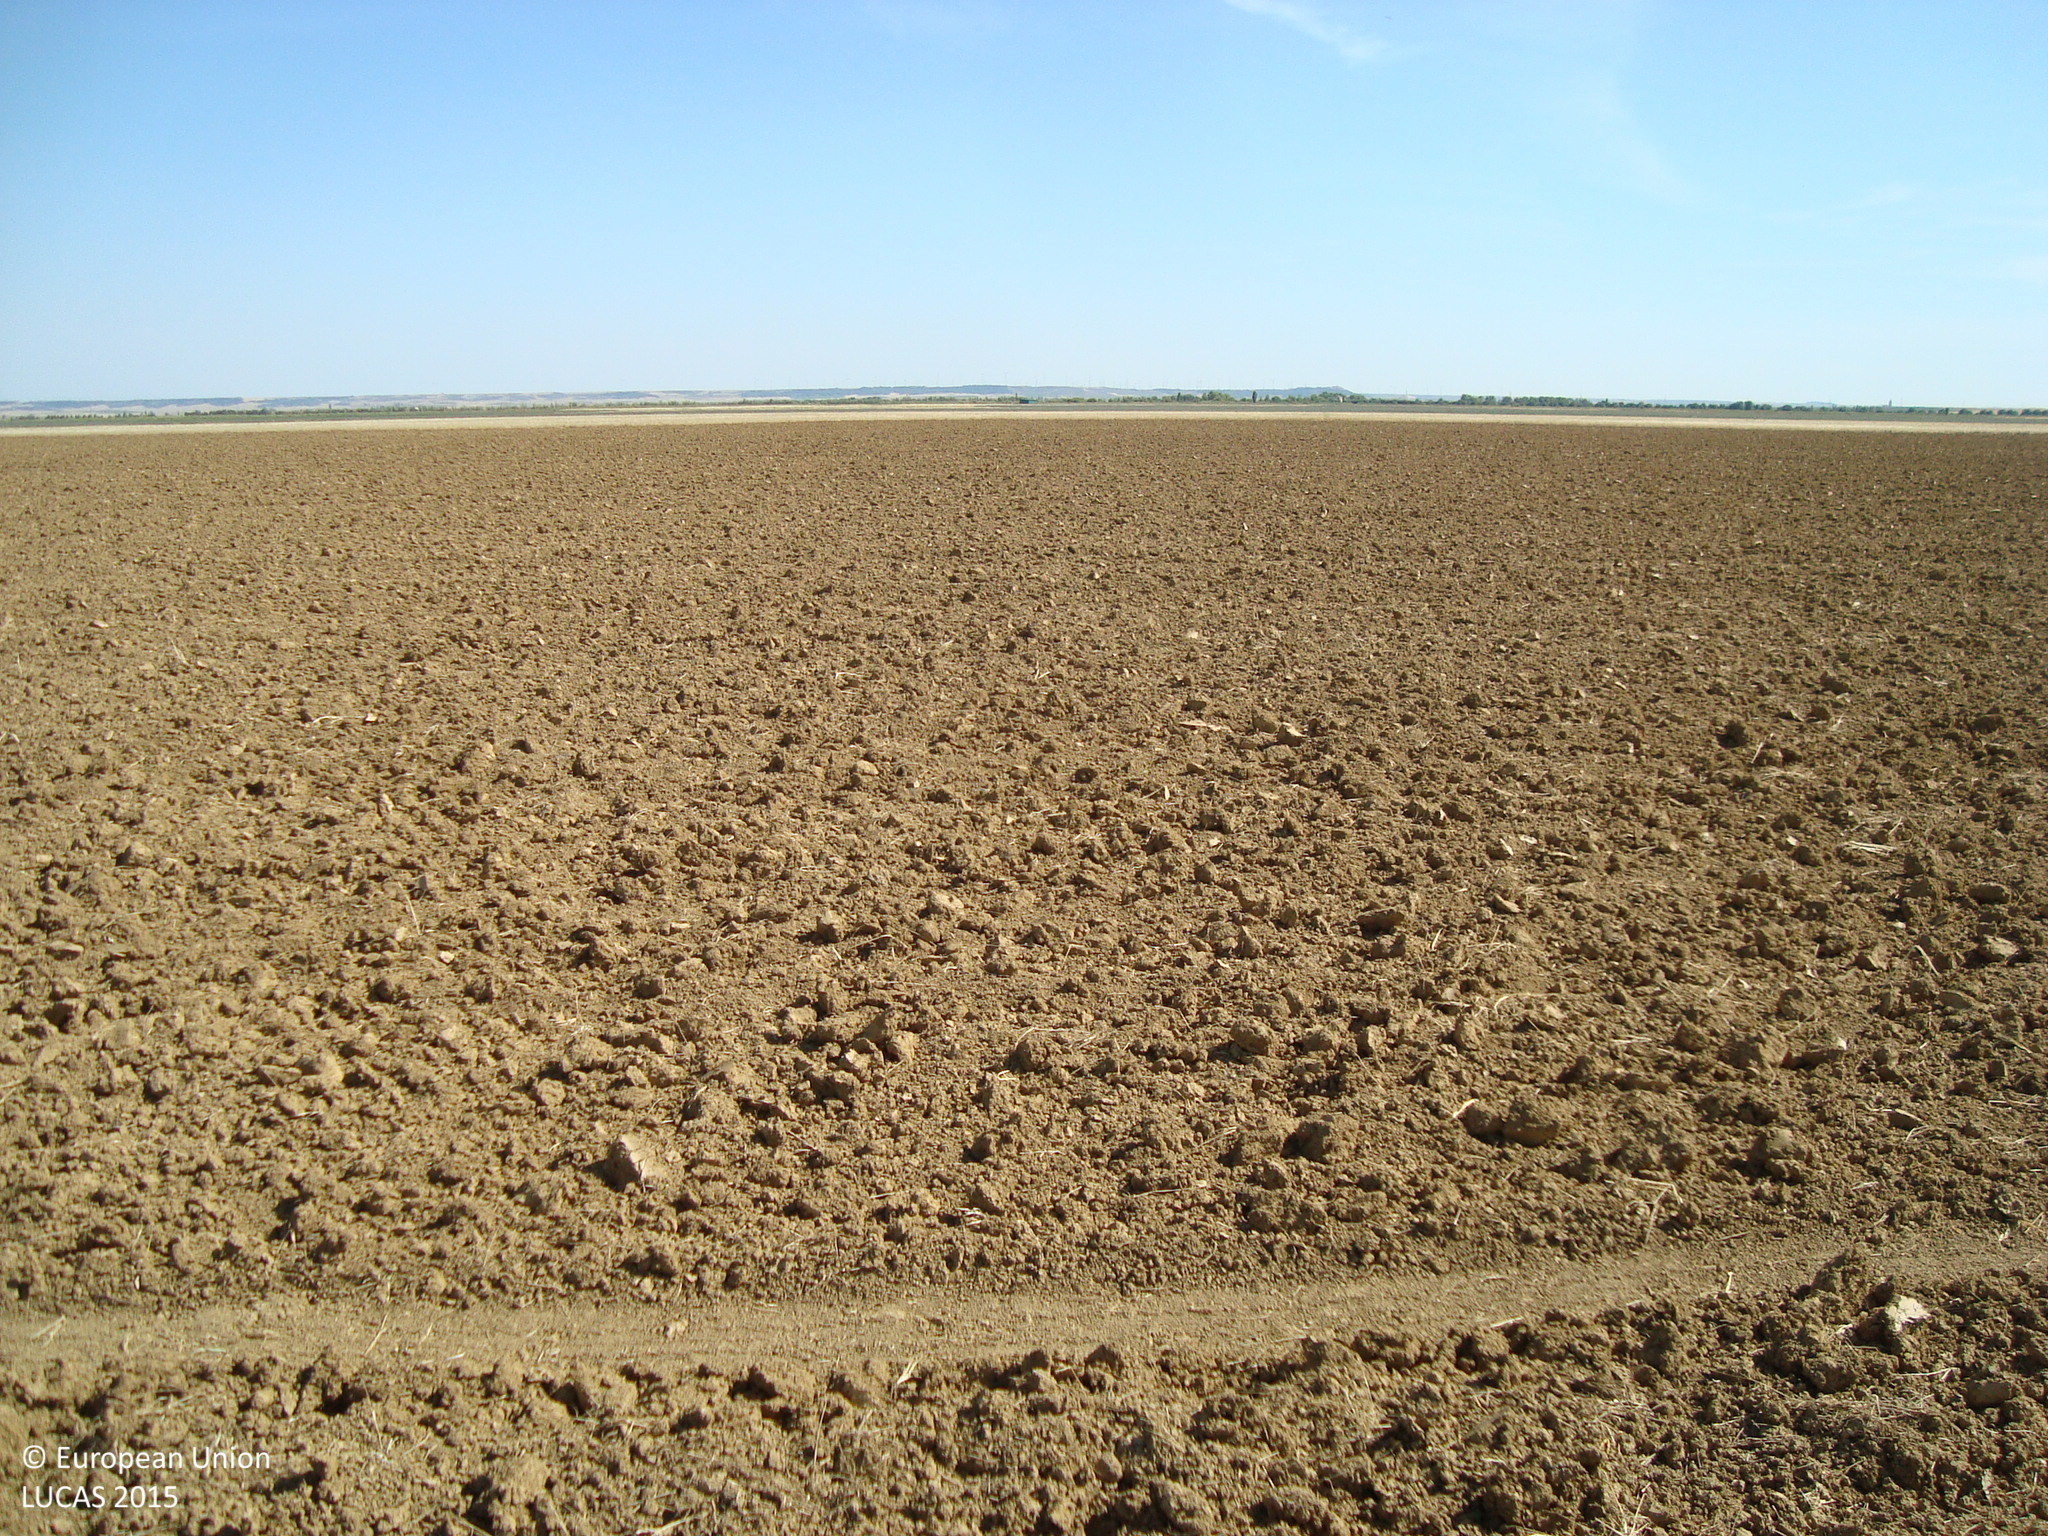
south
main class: Cropland
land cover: Lucerne
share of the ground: > 75 %
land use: Agriculture (excluding fallow land and kitchen gardens)
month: July
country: ES
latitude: 42.0823
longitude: -4.7379
